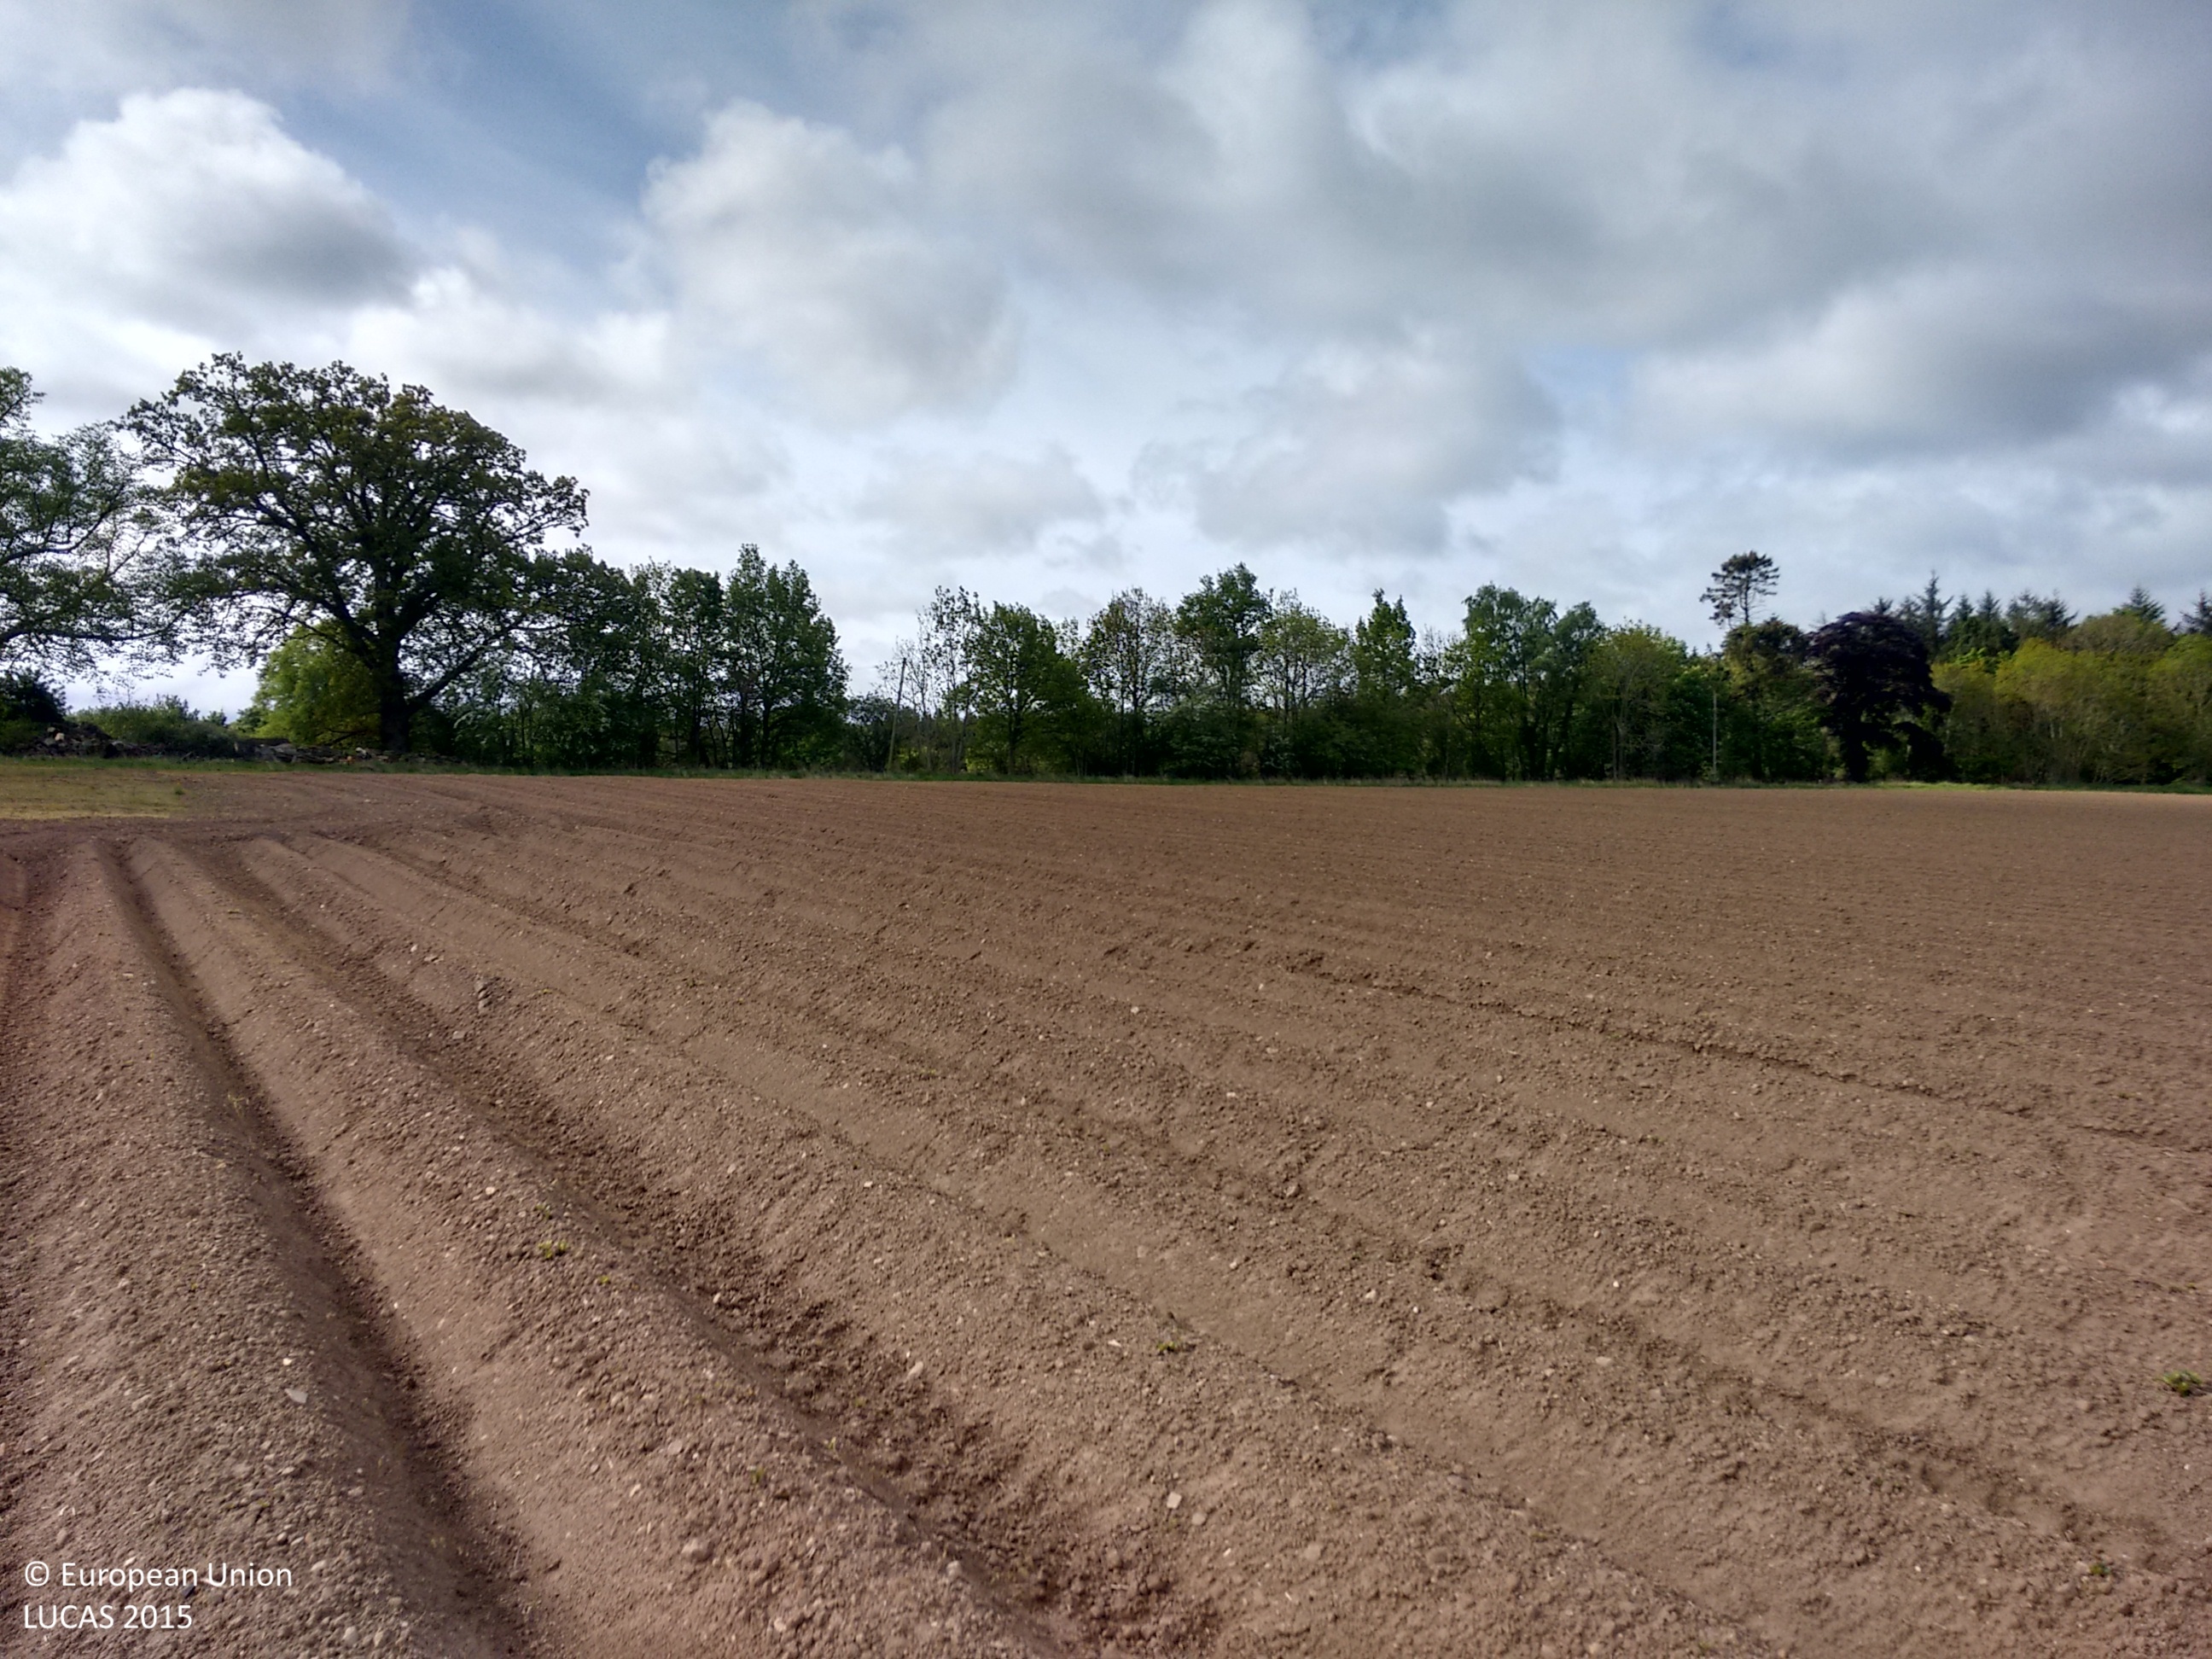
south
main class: Cropland
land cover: Potatoes
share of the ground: < 10 %
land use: Agriculture (excluding fallow land and kitchen gardens)
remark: Tilled/Sowed
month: May
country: GB
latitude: 55.9450
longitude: -2.7939
